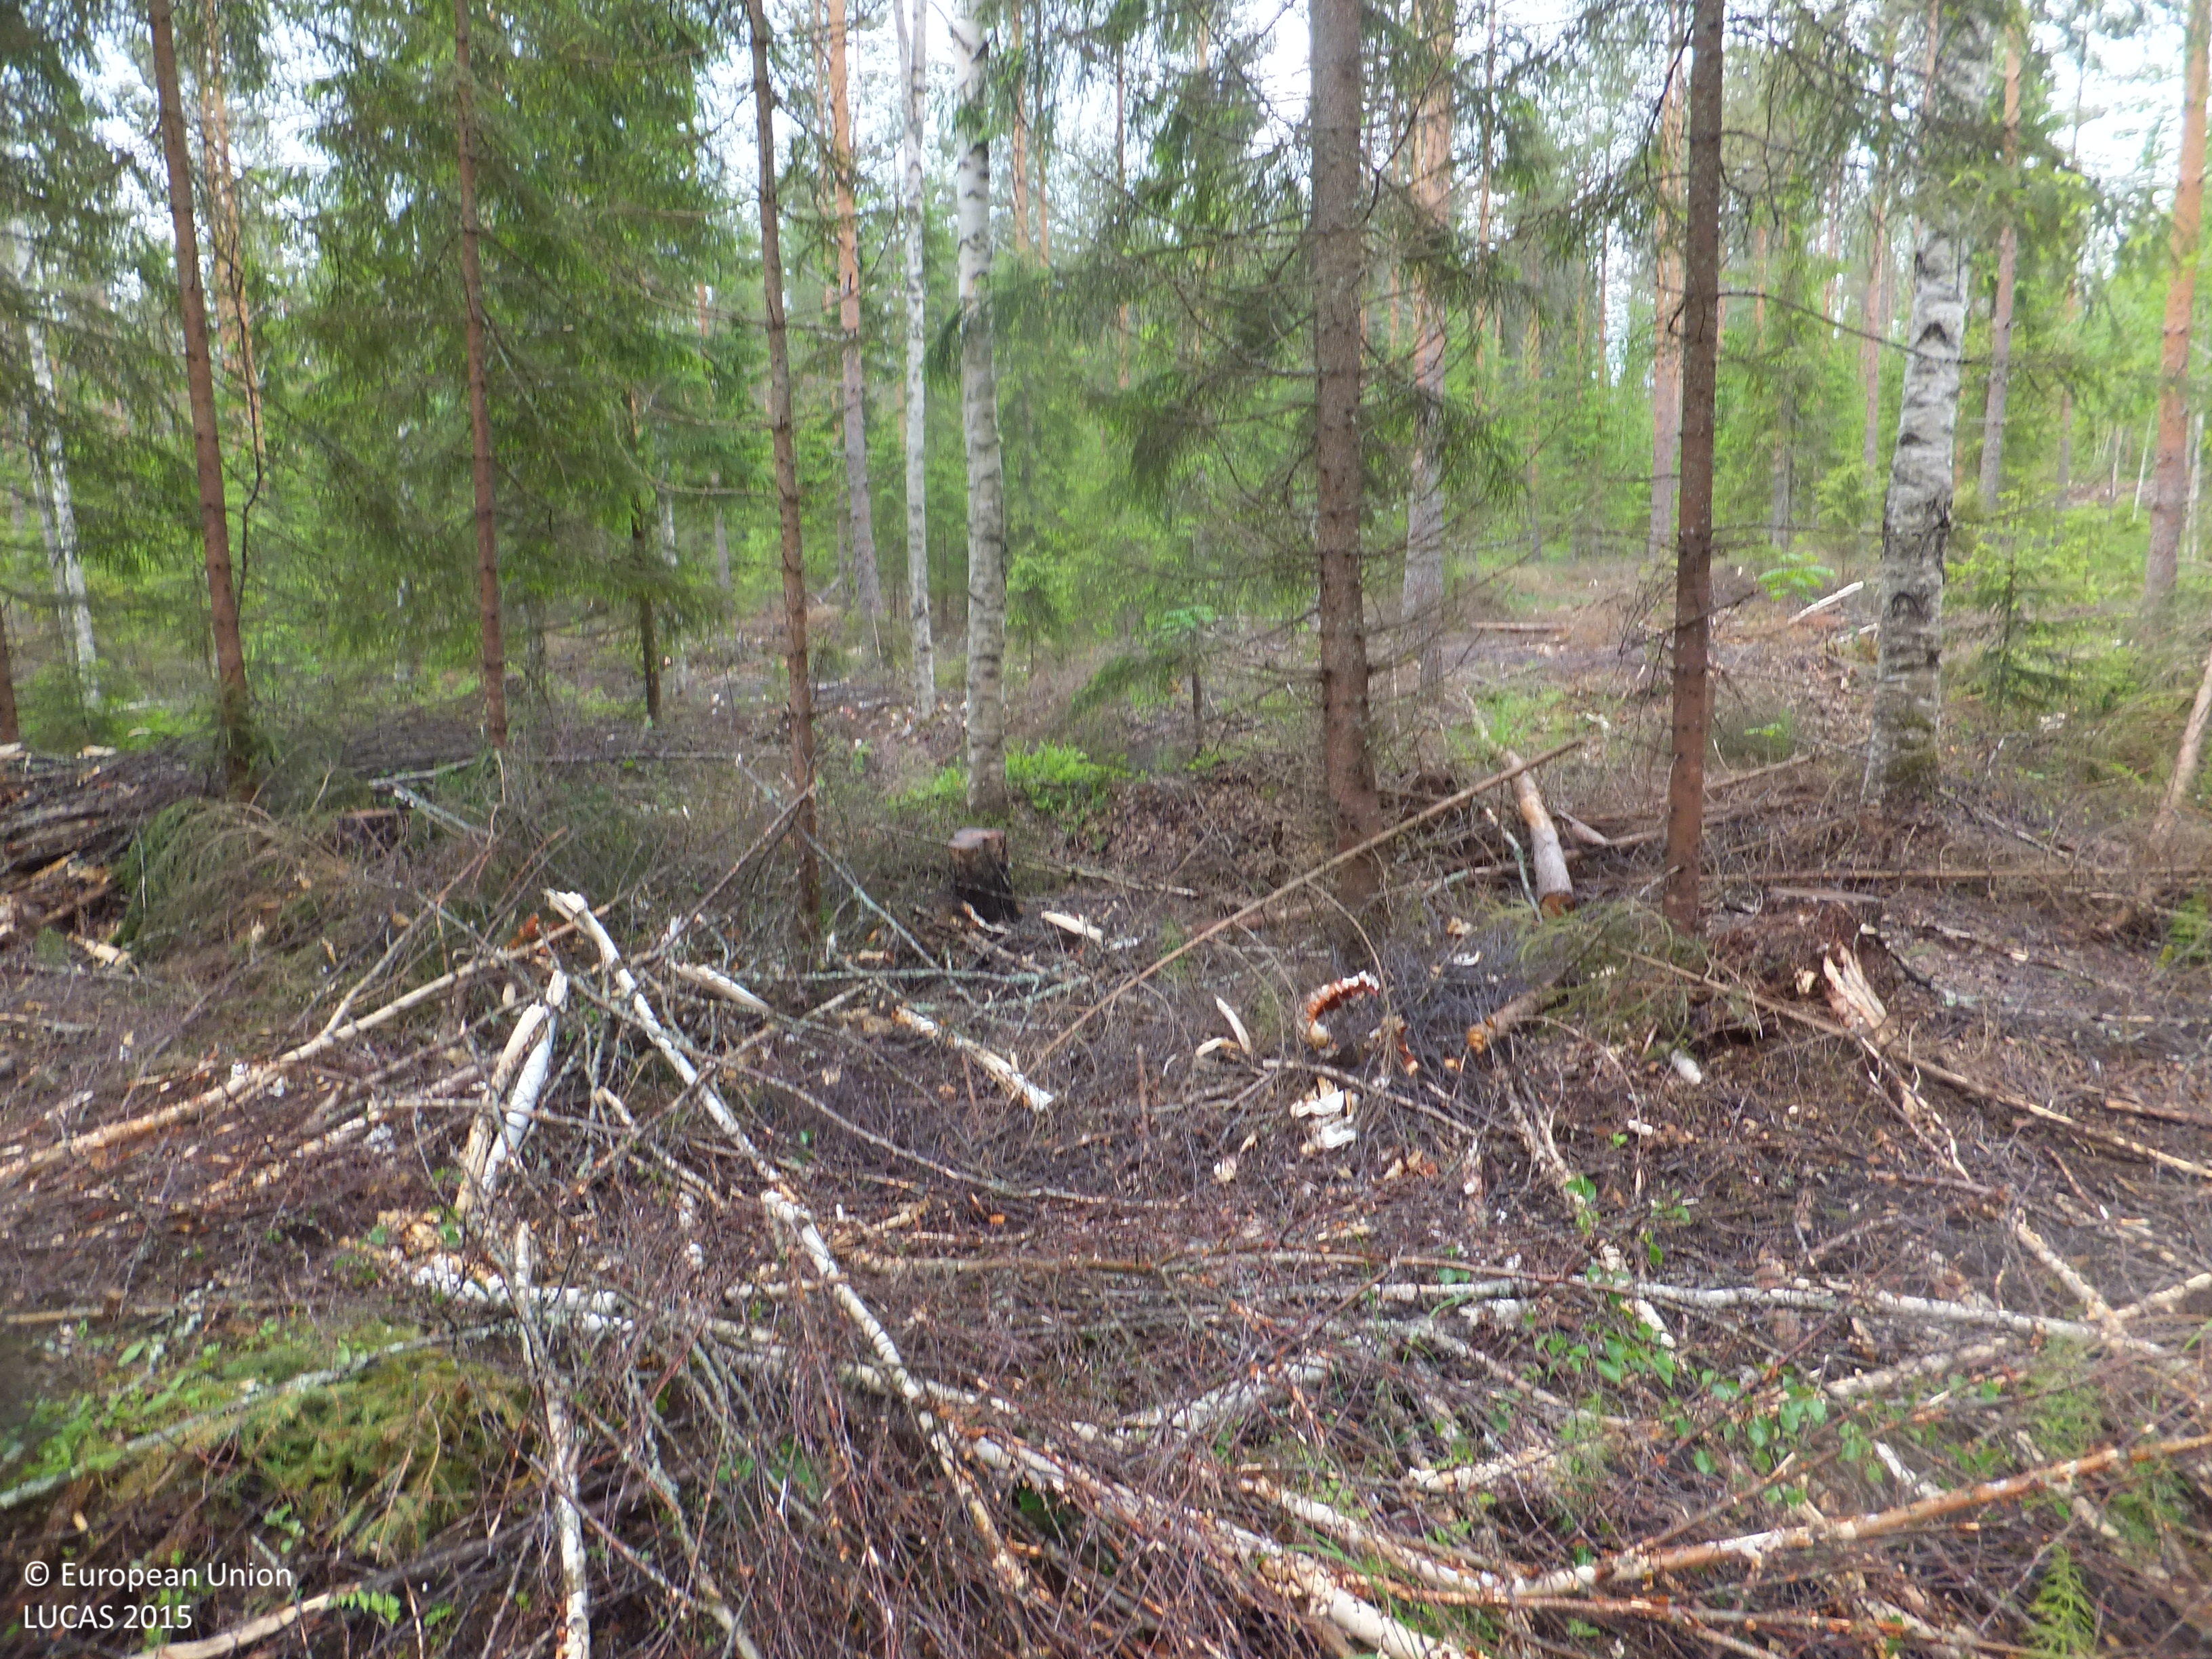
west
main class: Woodland
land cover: Pine dominated coniferous woodland
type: boreal forest
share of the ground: > 75 %
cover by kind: coniferous forest trees 75 %, broadleaved forest trees 10 %, shrubs 10 %, lichens and mosses 5 %
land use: Forestry
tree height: > 5 m
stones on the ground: < 10 %
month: June
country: FI
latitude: 63.6456
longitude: 24.9685
